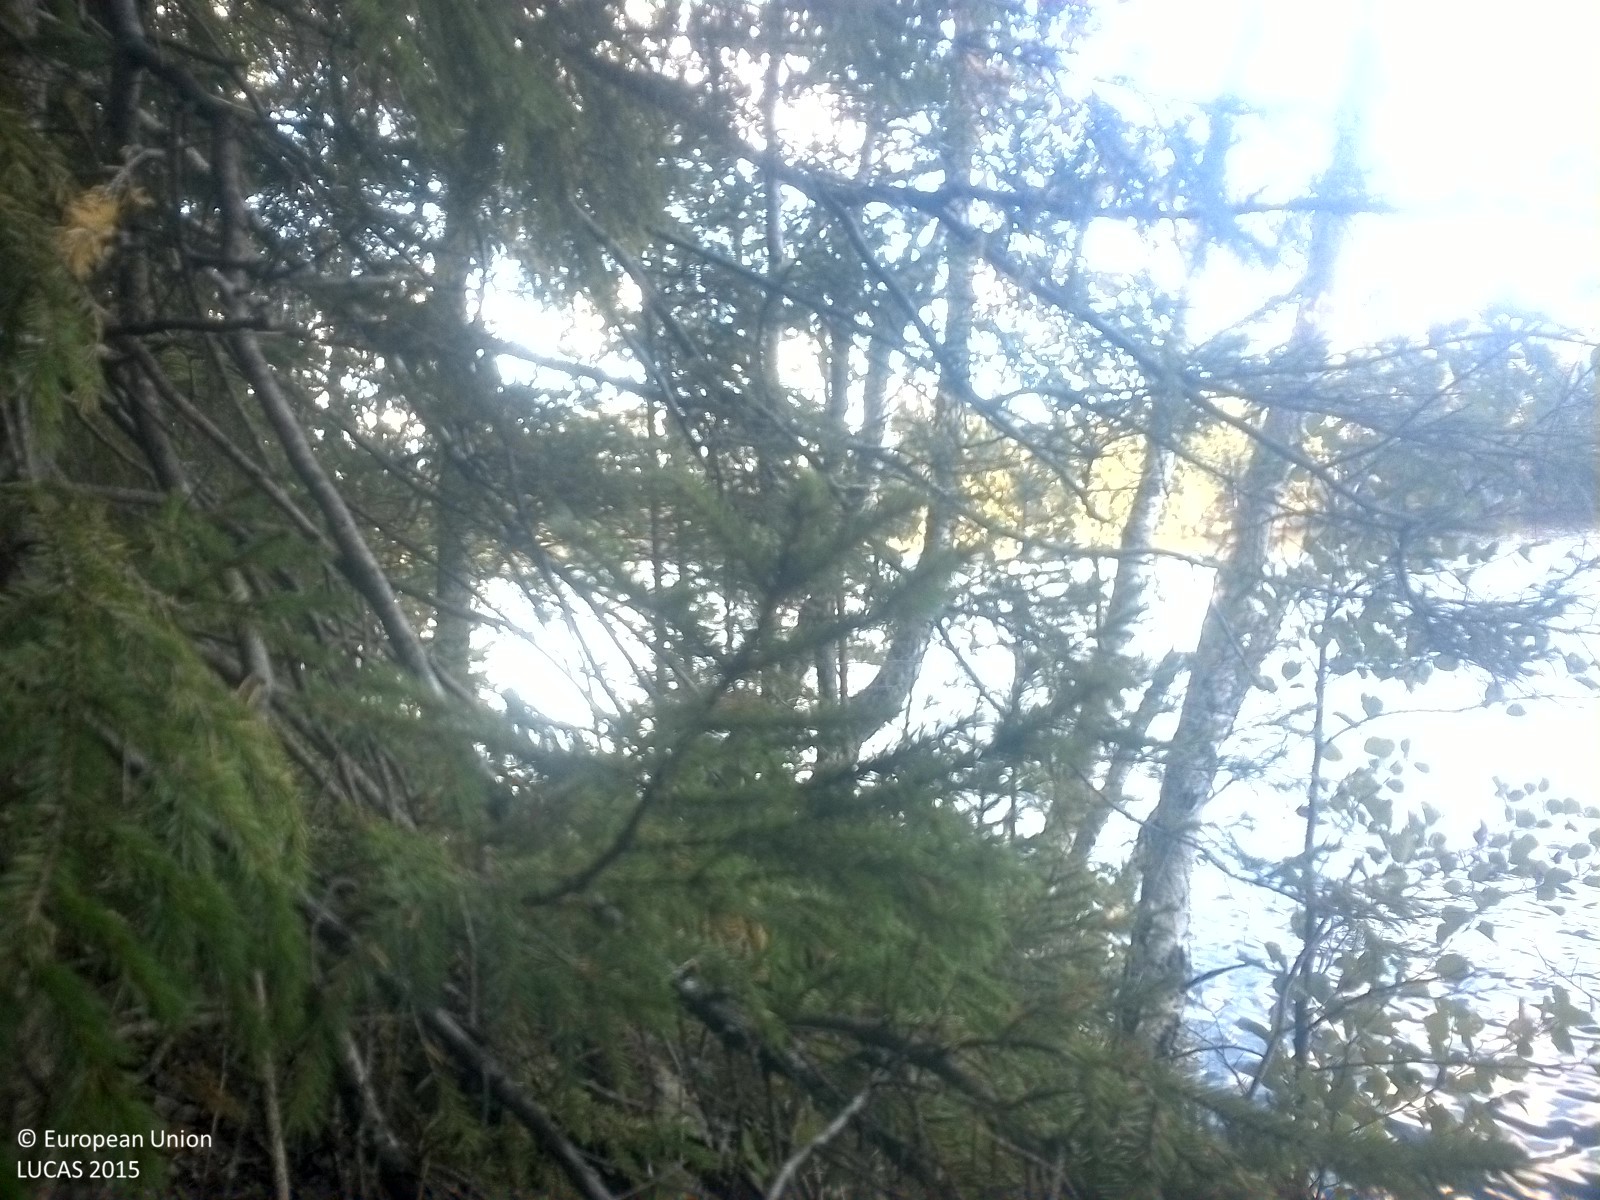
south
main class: Woodland
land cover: Spruce dominated mixed woodland
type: boreal forest
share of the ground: 50 - 75 %
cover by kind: coniferous forest trees 35 %, herbaceous plants 35 %, broadleaved forest trees 20 %, lichens and mosses 10 %
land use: Forestry
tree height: > 5 m
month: September
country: SE
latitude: 58.7607
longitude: 16.2354
